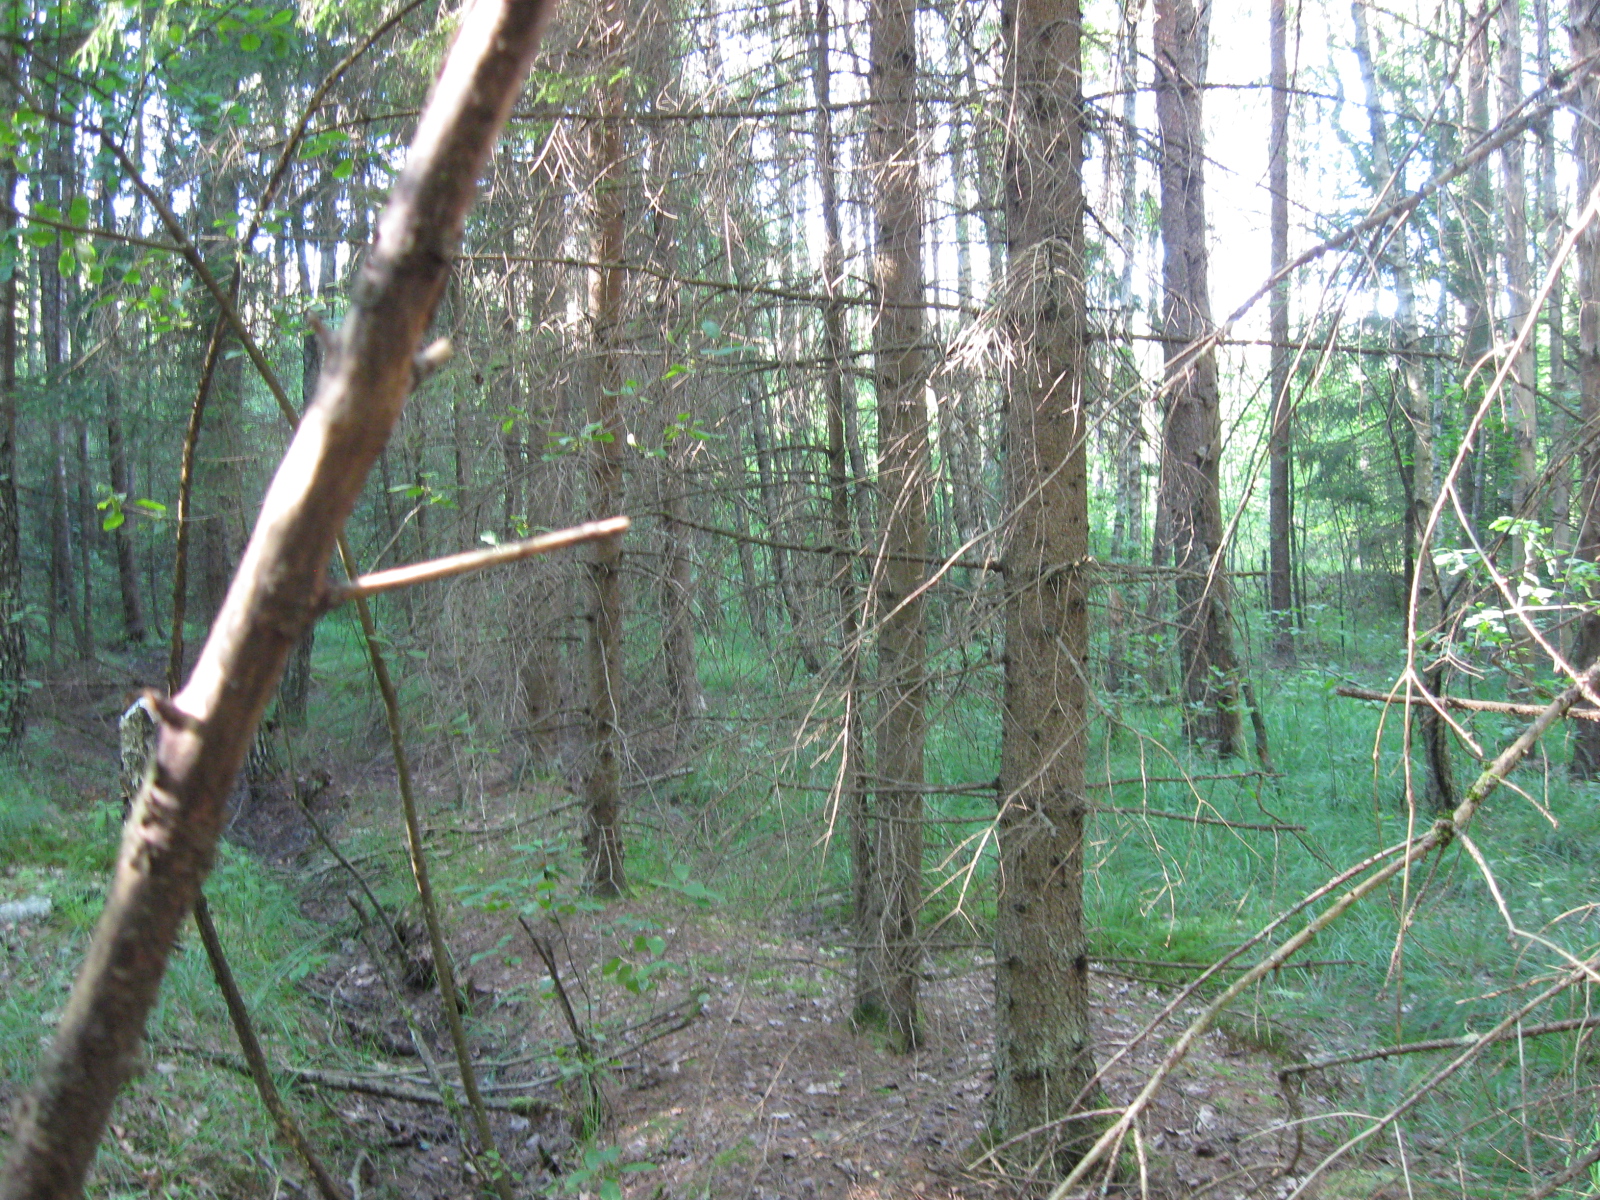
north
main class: Woodland
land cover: Spruce dominated mixed woodland
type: hemiboreal forest and nemoral coniferous forest and mixed broadleaved-coniferous forest
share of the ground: > 75 %
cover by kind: coniferous forest trees 55 %, broadleaved forest trees 30 %, herbaceous plants 10 %, unconsolidated bare surface 5 %
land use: Forestry
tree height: > 5 m
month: August
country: LT
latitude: 54.8712
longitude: 23.4662
